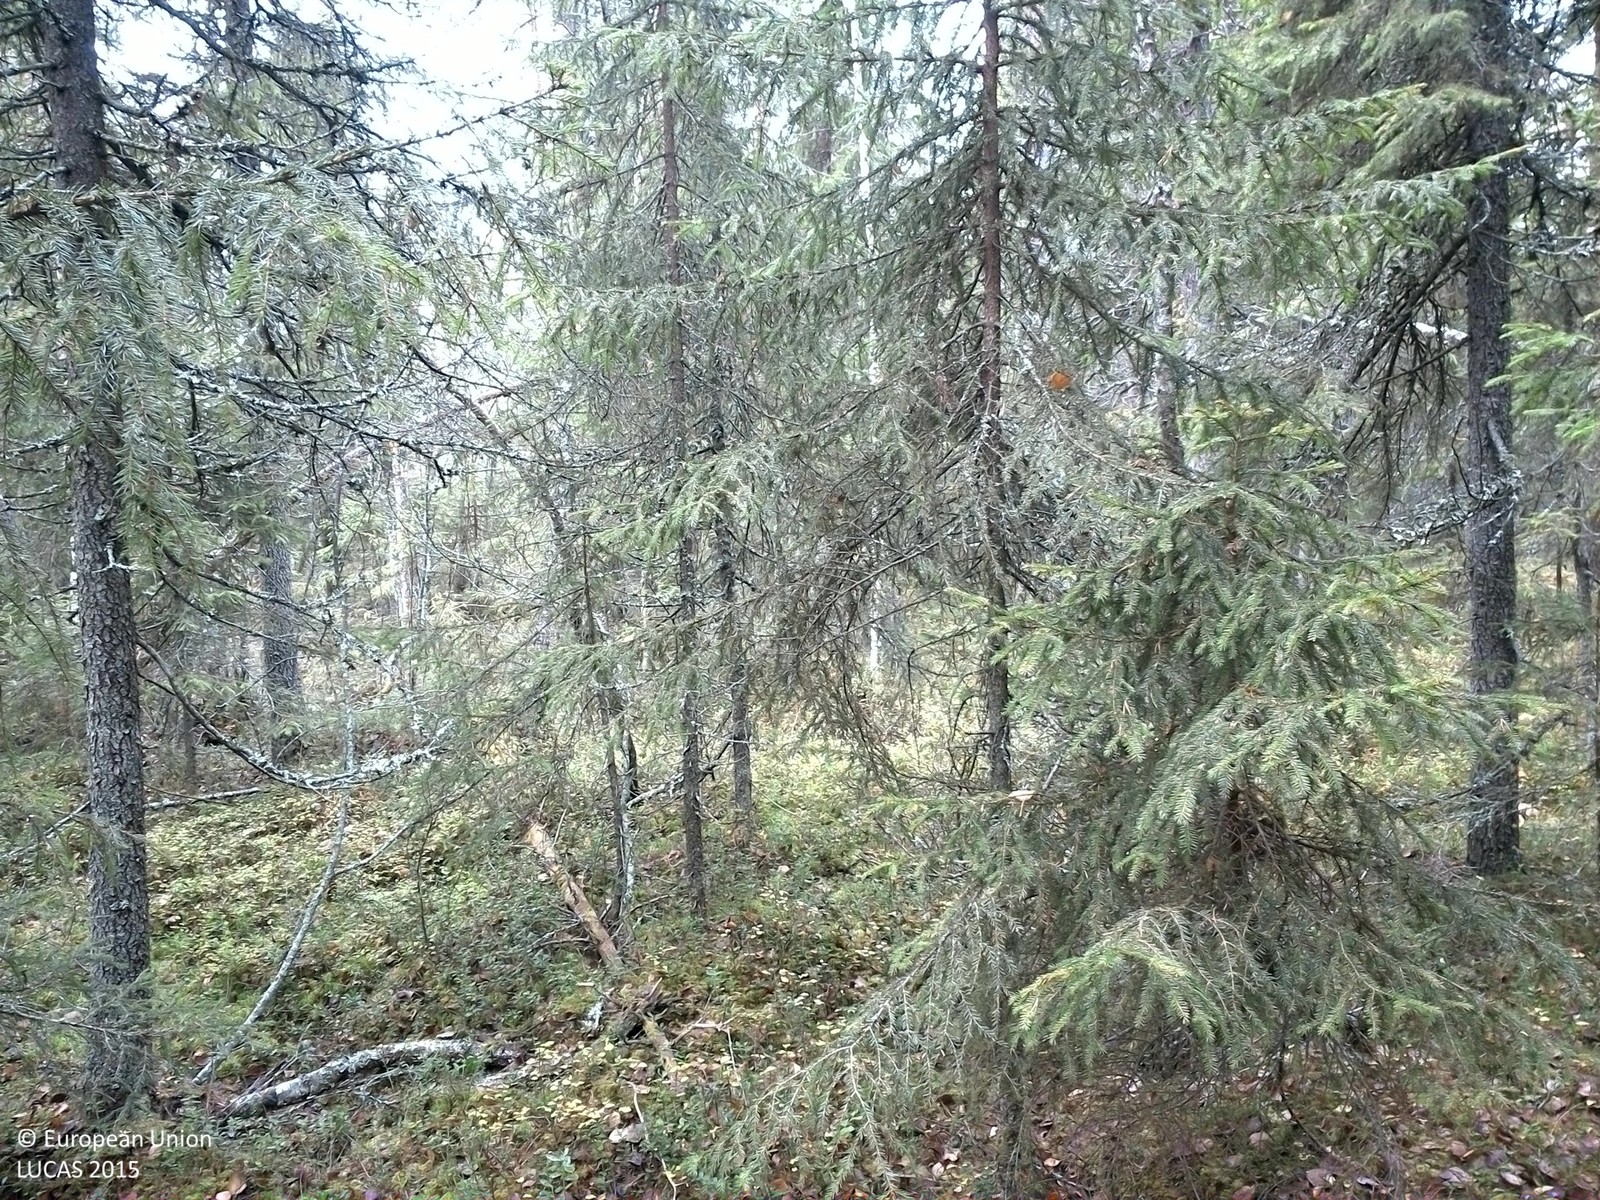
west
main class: Woodland
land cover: Spruce dominated mixed woodland
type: boreal forest
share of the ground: 50 - 75 %
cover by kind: coniferous forest trees 50 %, broadleaved forest trees 20 %, shrubs 20 %, lichens and mosses 10 %
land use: Forestry
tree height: > 5 m
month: October
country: SE
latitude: 64.1221
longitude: 15.9878
